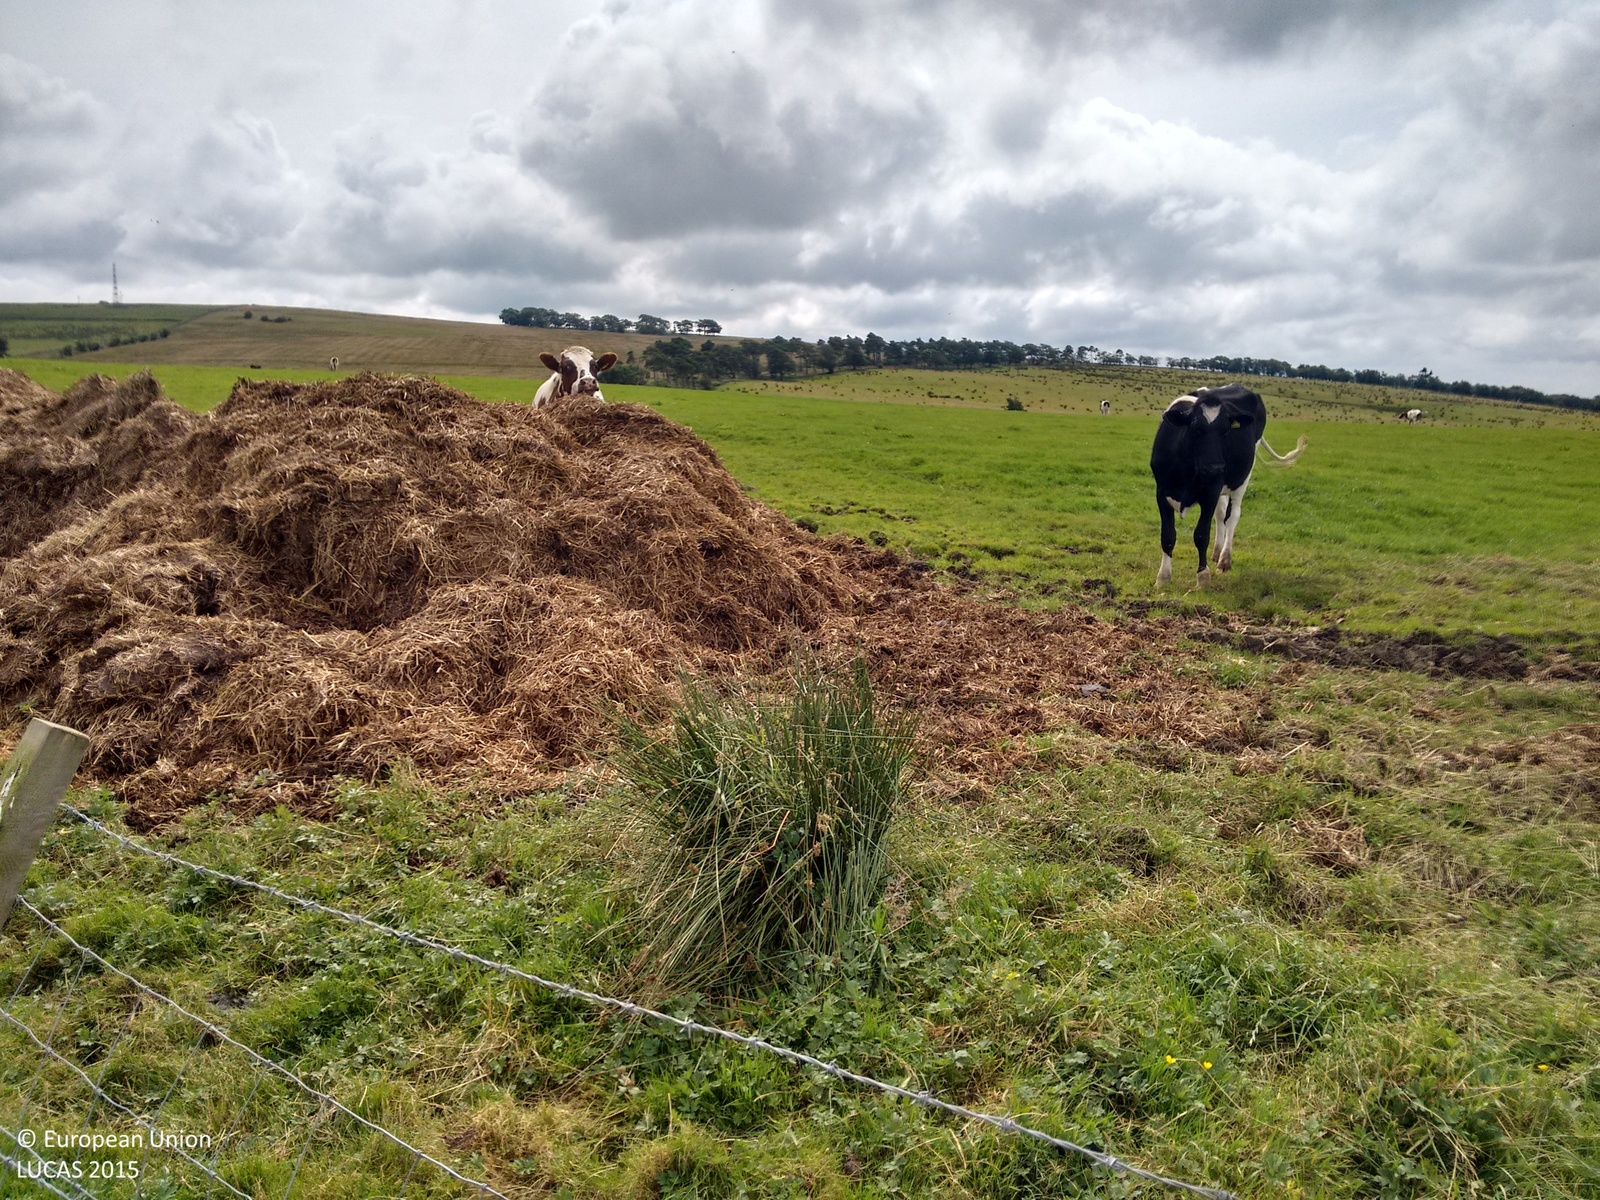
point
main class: Grassland
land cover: Grassland without tree/shrub cover
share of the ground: > 75 %
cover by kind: herbaceous plants 100 %
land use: Agriculture (excluding fallow land and kitchen gardens)
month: August
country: GB
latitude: 55.4460
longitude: -4.2113
